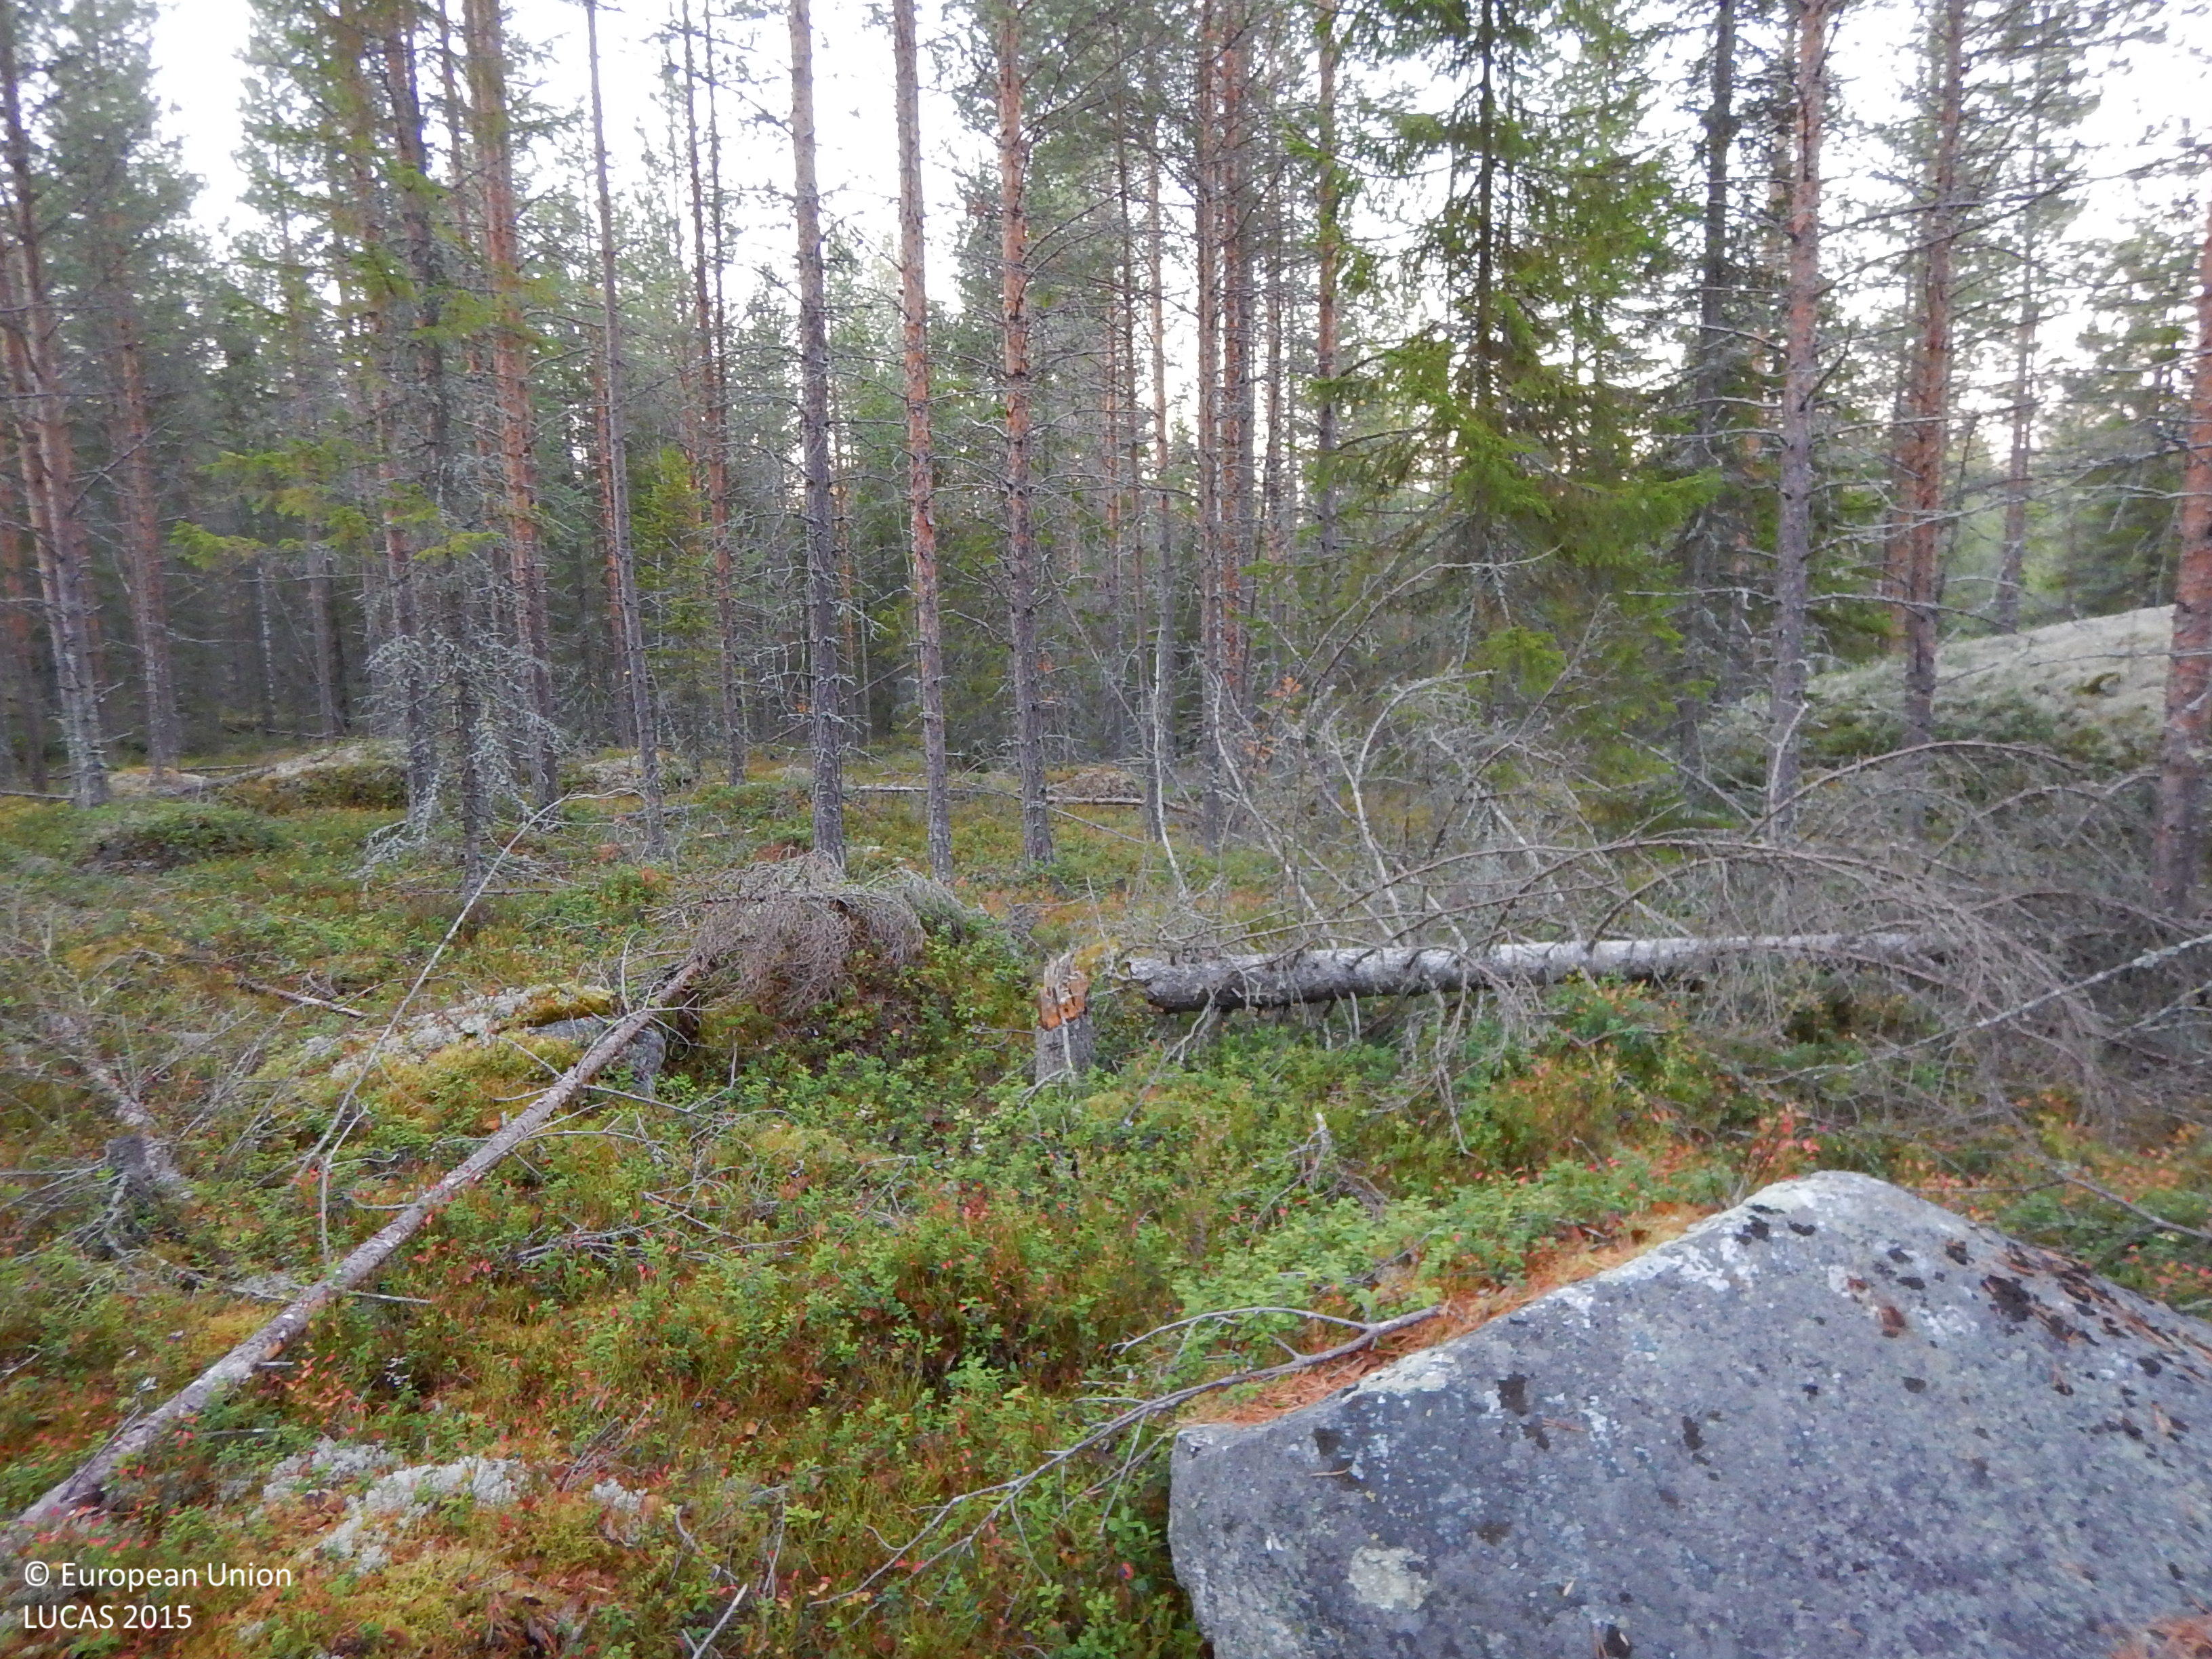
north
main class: Woodland
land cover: Pine dominated coniferous woodland
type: boreal forest
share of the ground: 50 - 75 %
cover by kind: coniferous forest trees 45 %, shrubs 20 %, lichens and mosses 20 %, broadleaved forest trees 5 %, herbaceous plants 5 %, consolidated bare surface 5 %
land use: Forestry
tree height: > 5 m
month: October
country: SE
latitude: 64.9317
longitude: 20.9543
